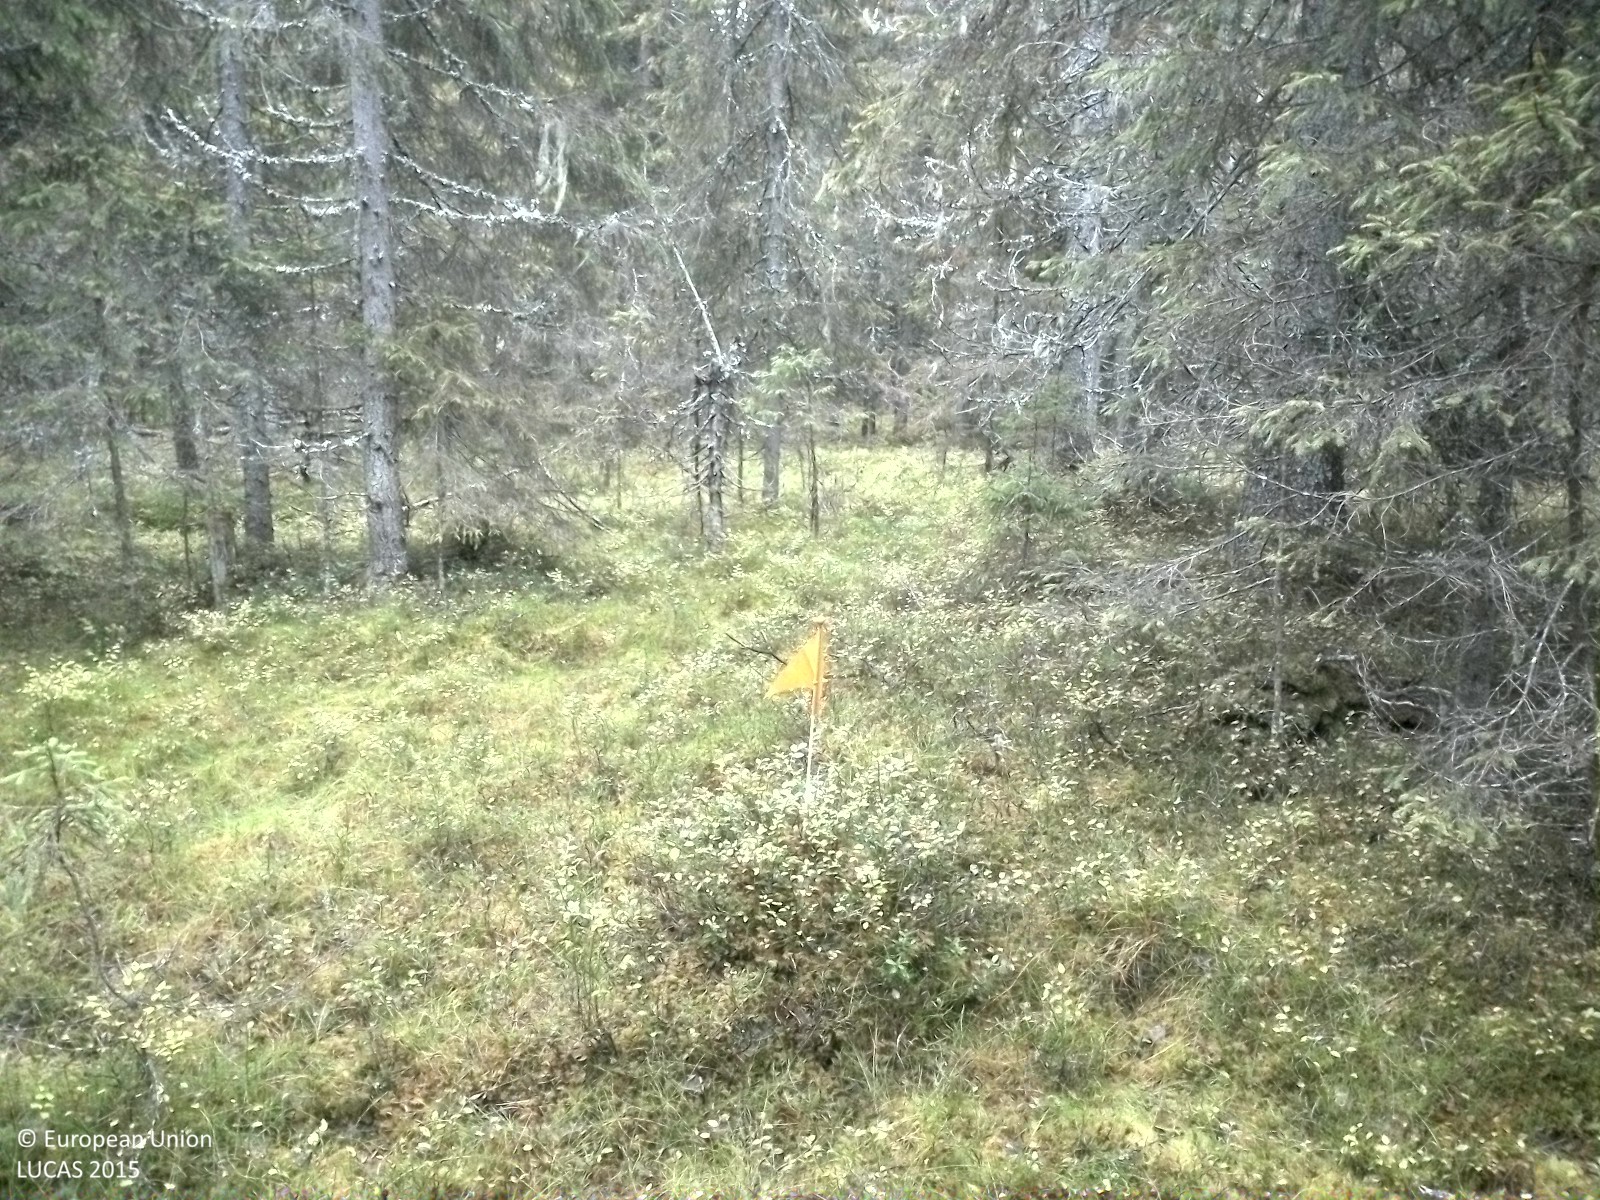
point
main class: Woodland
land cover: Spruce dominated coniferous woodland
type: boreal forest
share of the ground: > 75 %
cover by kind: coniferous forest trees 90 %, shrubs 10 %
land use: Forestry
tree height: > 5 m
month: October
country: SE
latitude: 63.5240
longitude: 14.9824
